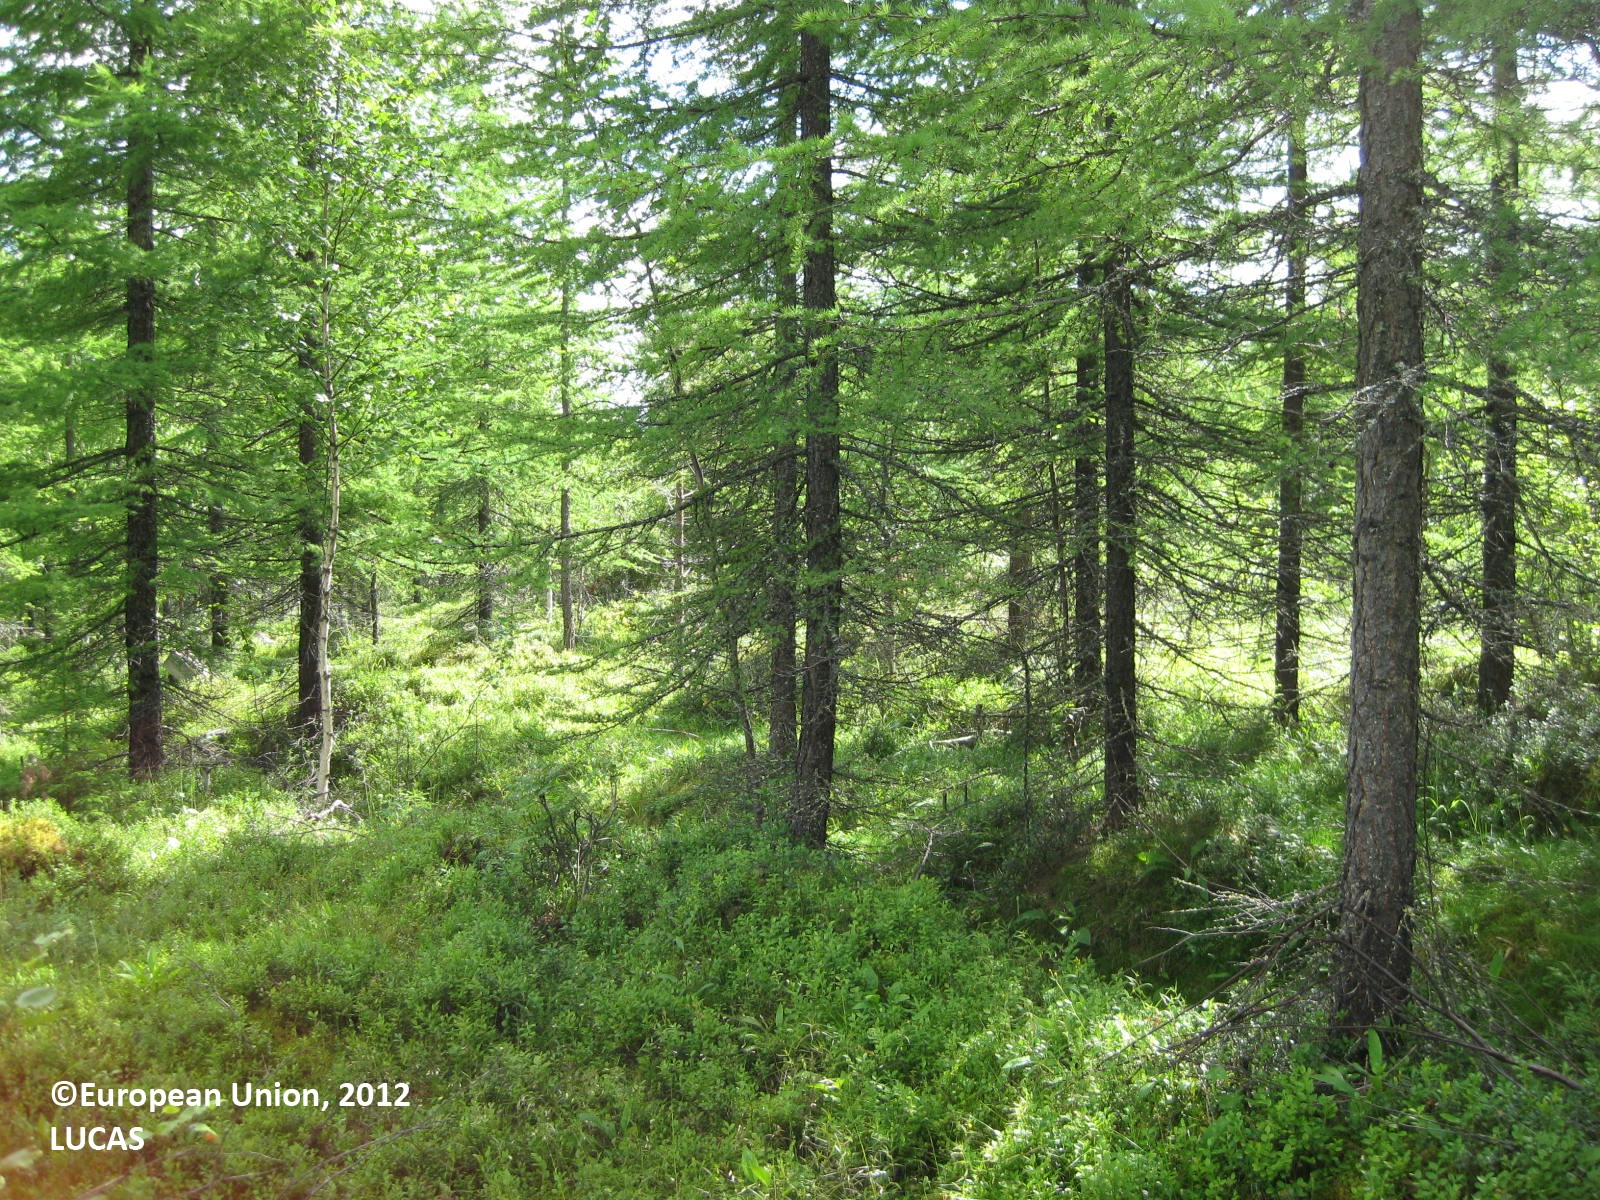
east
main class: Woodland
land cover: Other coniferous woodland
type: boreal forest
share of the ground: 50 - 75 %
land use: Forestry
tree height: > 5 m
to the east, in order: Other coniferous woodland; Ditches and canals; Other coniferous woodland; Ditches and canals; Other coniferous woodland; Ditches and canals; Other coniferous woodland; Ditches and canals; Other mixed woodland; Spontaneously vegetated surfaces; Ditches and canals; Other coniferous woodland; Ditches and canals; Other mixed woodland; Ditches and canals; Other mixed woodland; Ditches and canals; Other mixed woodland; Ditches and canals; Other mixed woodland; Ditches and canals; Other mixed woodland; Ditches and canals; Other mixed woodland; Ditches and canals; Other mixed woodland; Ditches and canals; Other mixed woodland; Ditches and canals; Other mixed woodland; Other bare soil; Tracks; Grass margins; Pine dominated mixed woodland; Ditches and canals; Pine dominated mixed woodland; Ditches and canals; Pine dominated mixed woodland; Ditches and canals; Pine dominated mixed woodland; Ditches and canals; Pine dominated mixed woodland
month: July
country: FI
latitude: 65.6764
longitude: 28.0958
